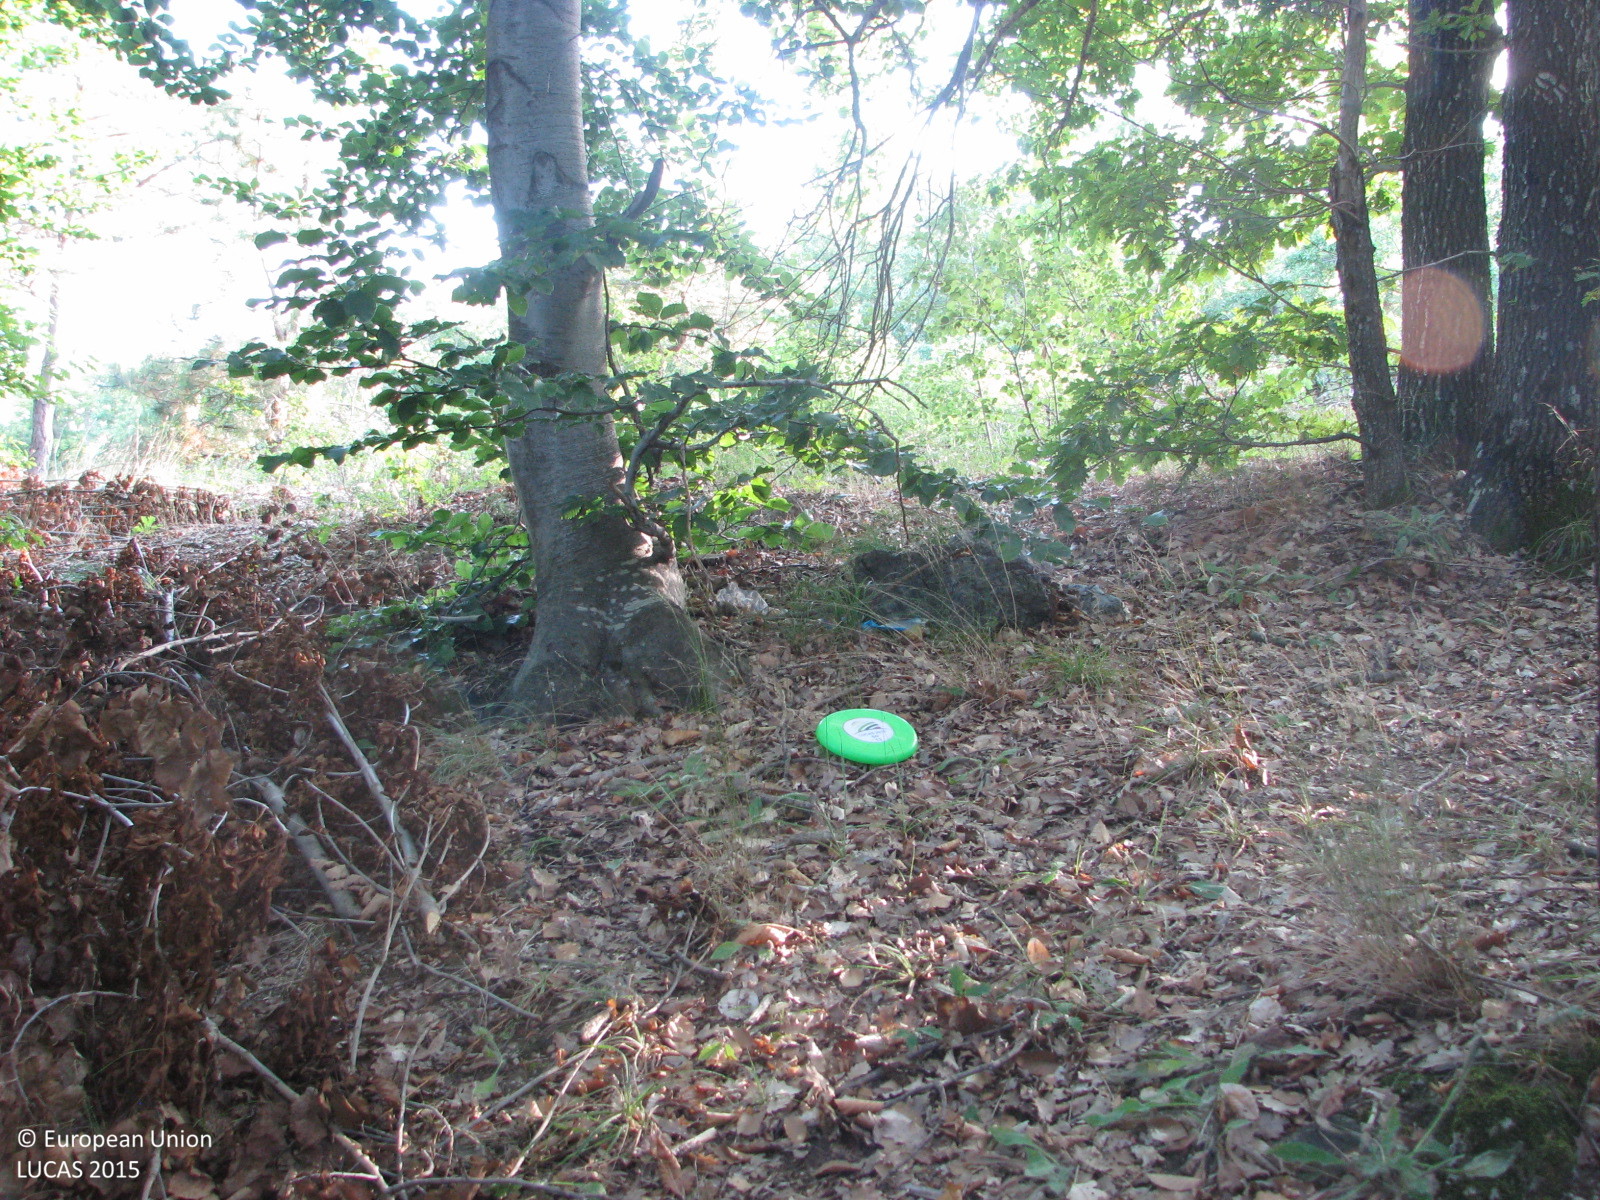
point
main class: Woodland
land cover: Broadleaved woodland
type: beech forest
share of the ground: 50 - 75 %
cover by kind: broadleaved forest trees 70 %, unconsolidated bare surface 20 %, shrubs 5 %, herbaceous plants 5 %
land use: Forestry
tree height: > 5 m
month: August
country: BG
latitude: 42.7212
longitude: 26.2952
